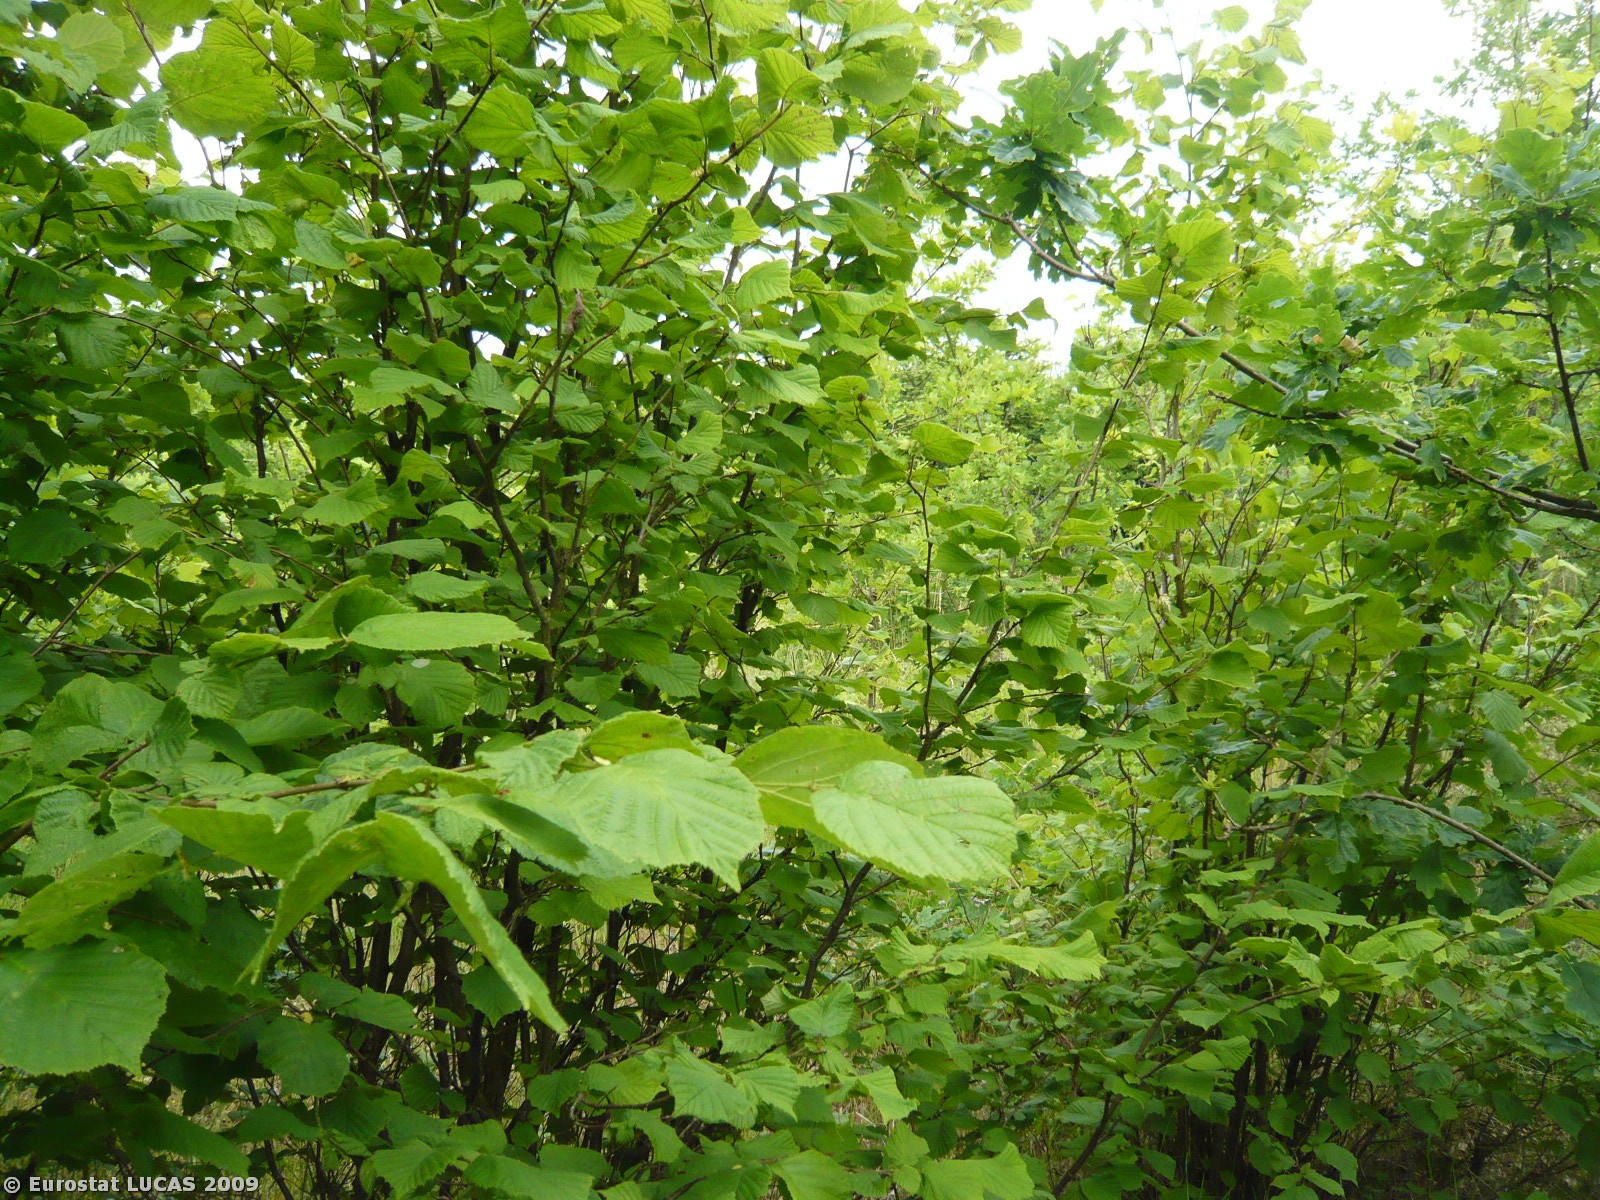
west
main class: Woodland
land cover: Broadleaved woodland
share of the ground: > 75 %
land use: Forestry
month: June
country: DK
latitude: 55.1991
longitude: 10.1413
